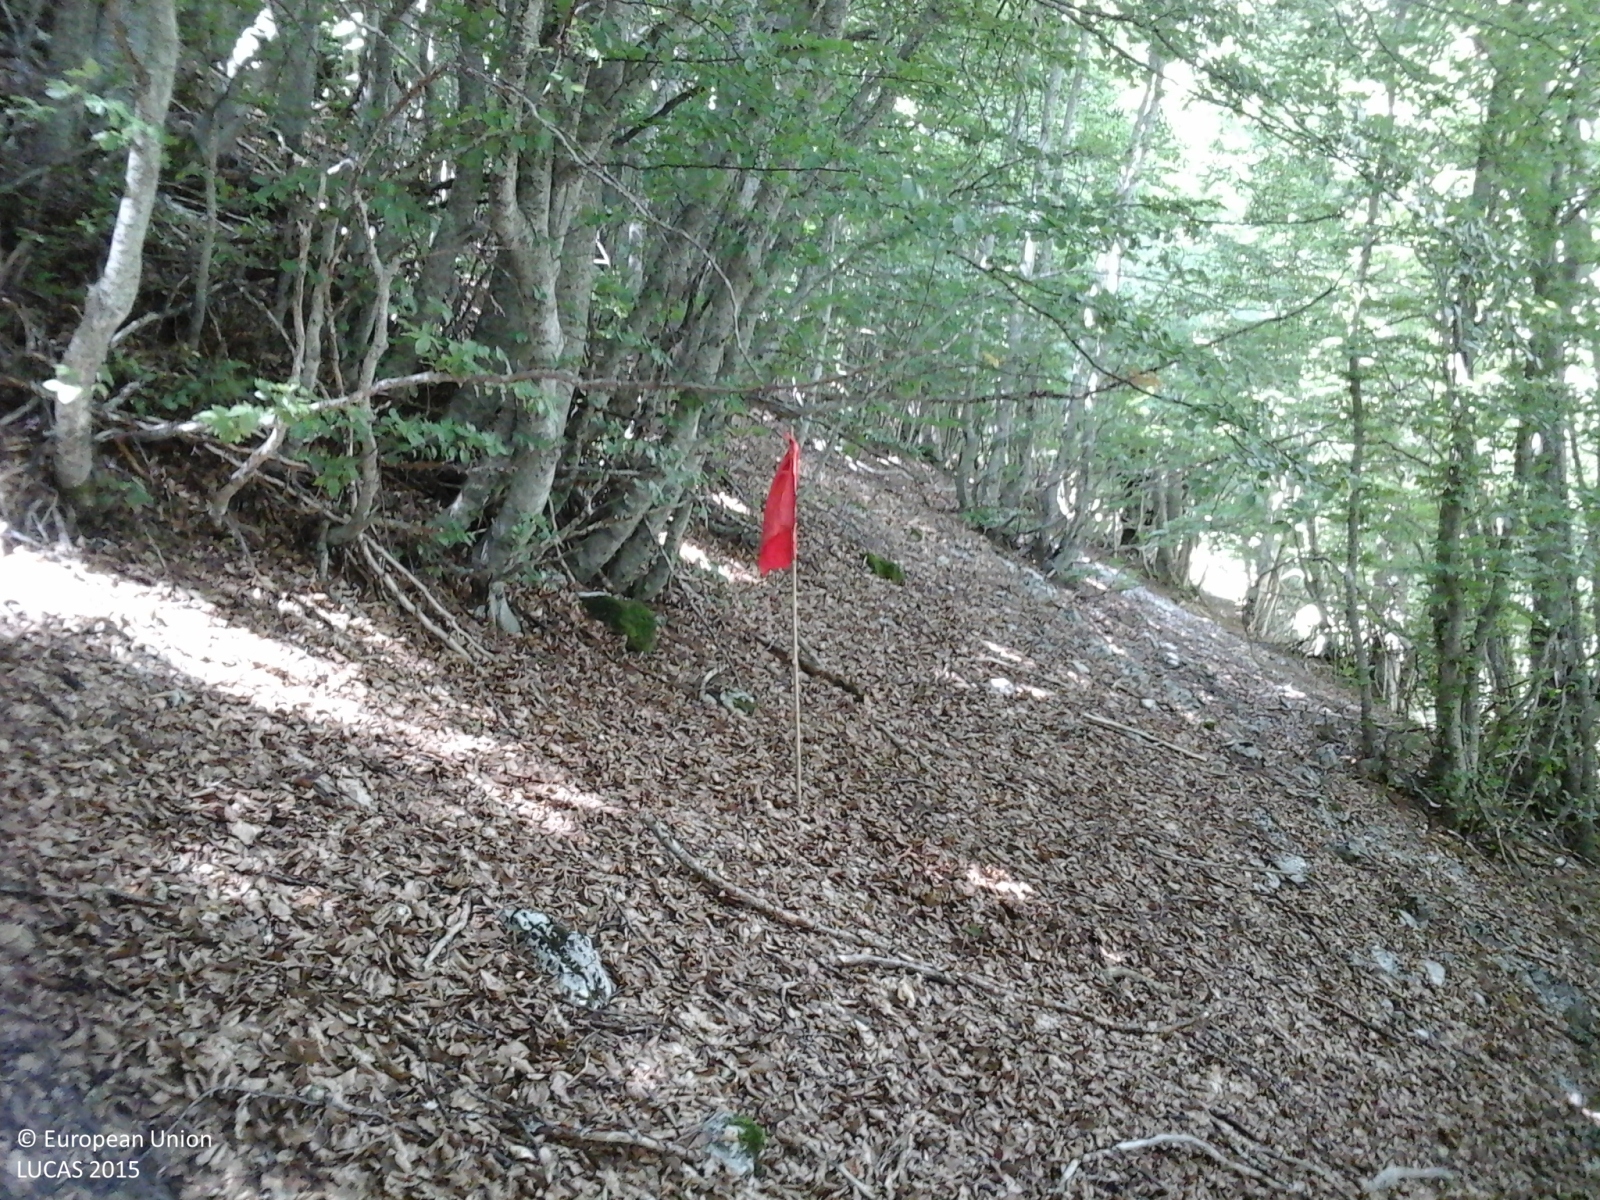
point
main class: Woodland
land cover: Broadleaved woodland
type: mountainous beech forest
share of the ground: > 75 %
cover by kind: broadleaved forest trees 100 %
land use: Forestry
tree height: > 5 m
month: August
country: IT
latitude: 42.8562
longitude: 13.2093
